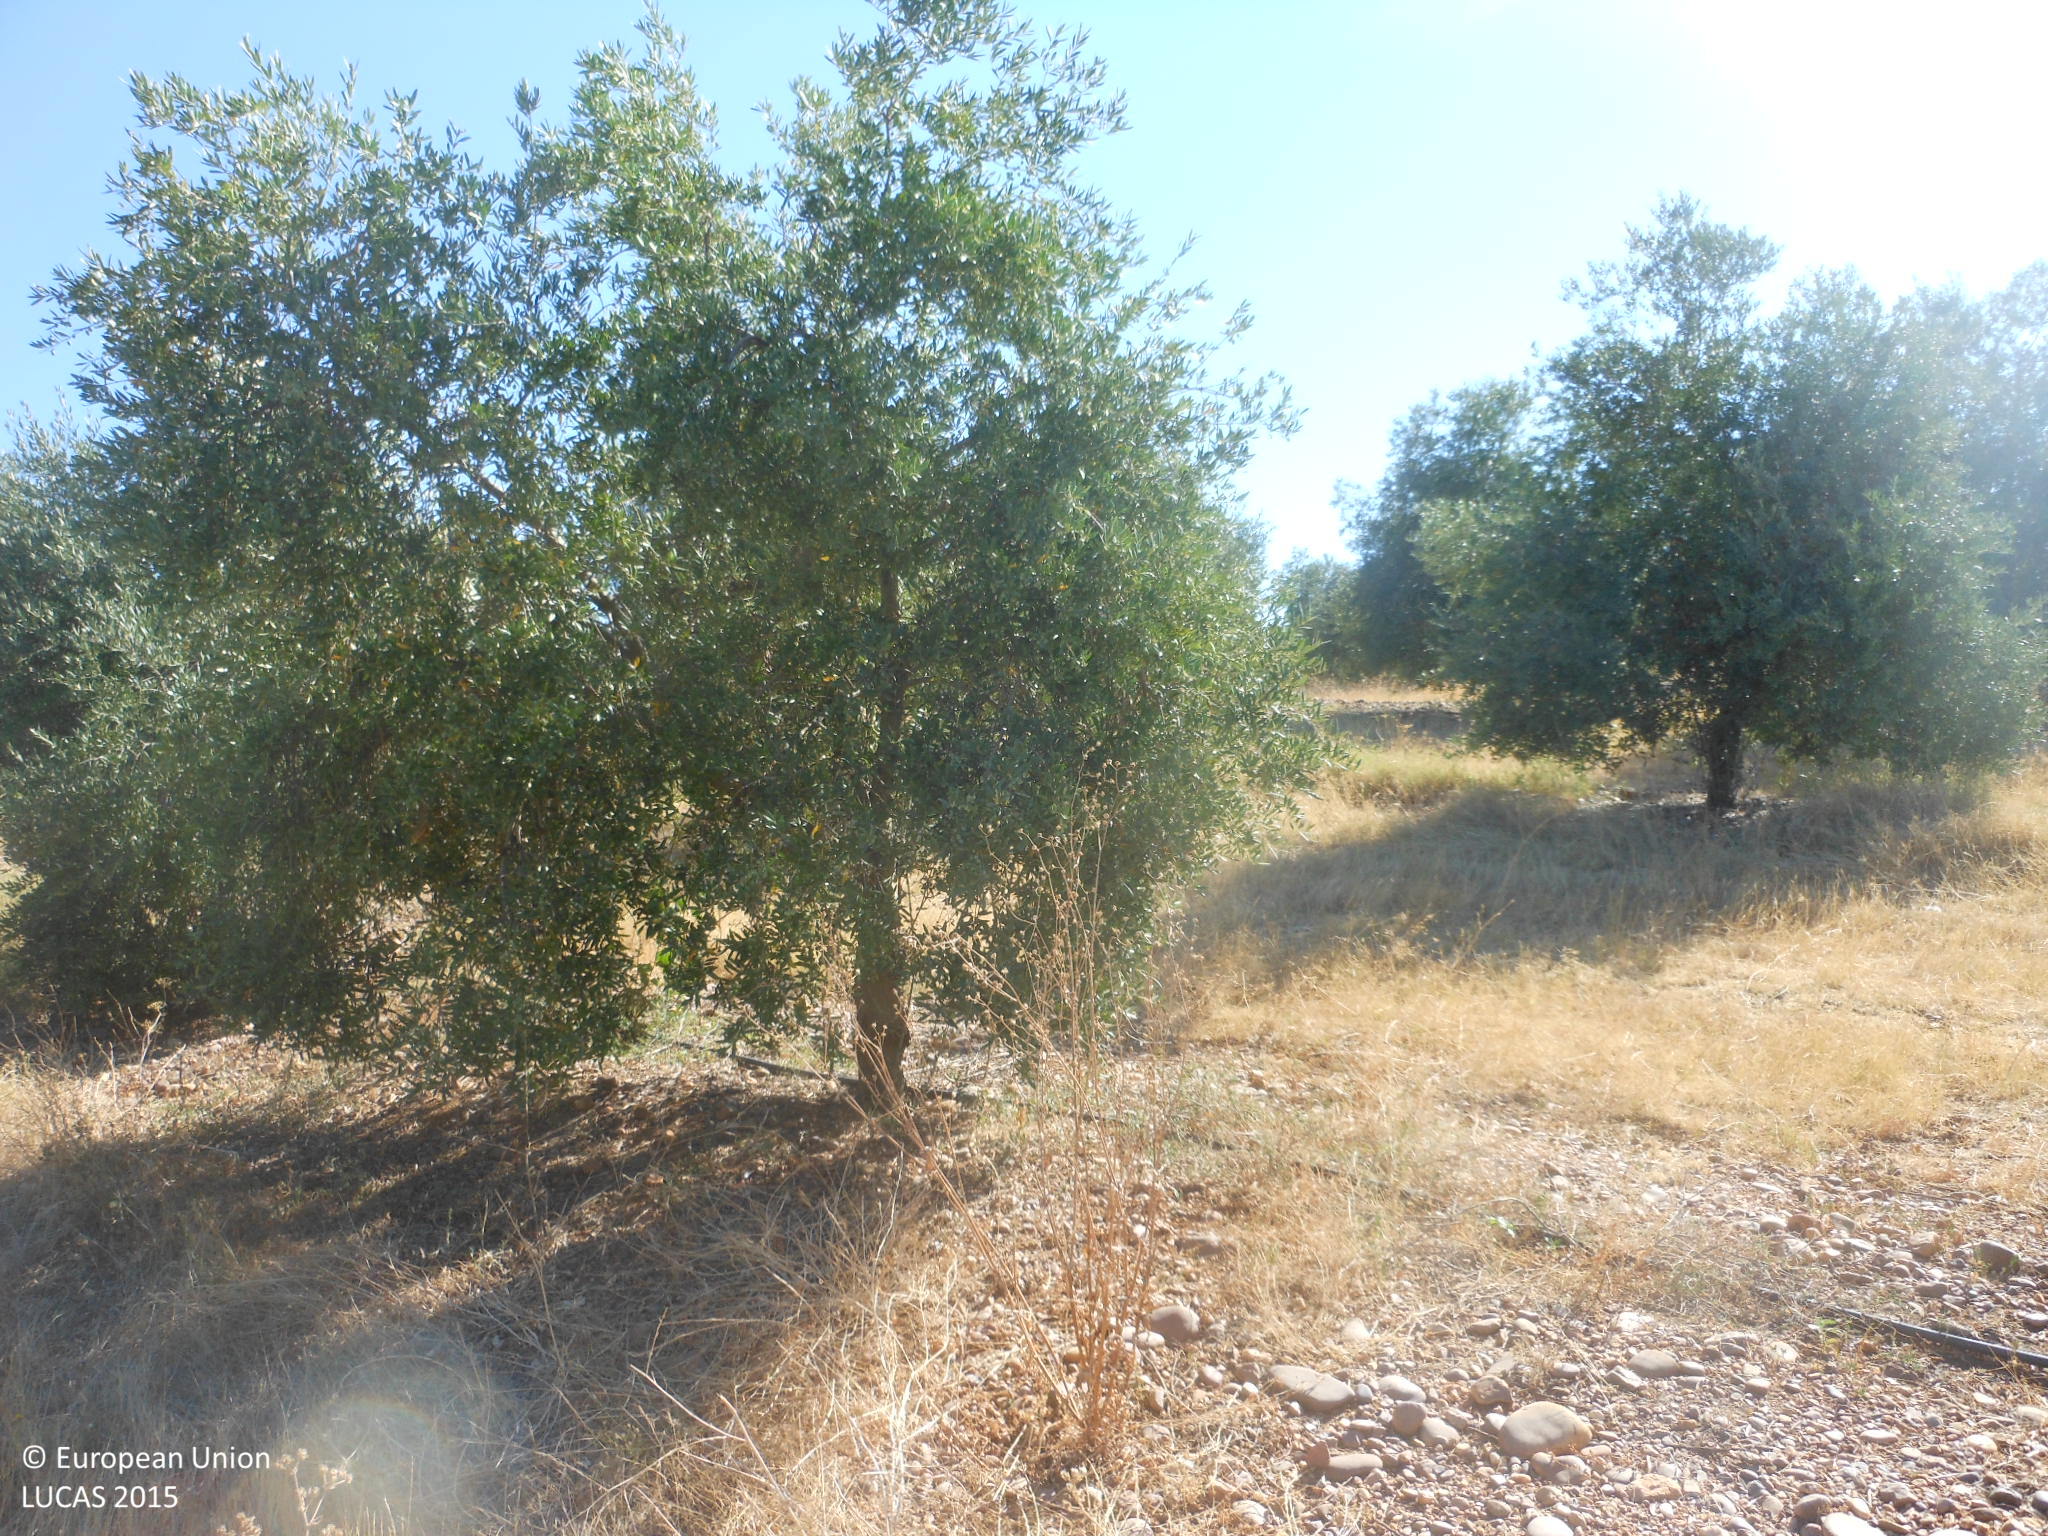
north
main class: Cropland
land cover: Olive groves
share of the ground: 25 - 50 %
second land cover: Spontaneously vegetated surfaces
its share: 50 - 75 %
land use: Agriculture (excluding fallow land and kitchen gardens)
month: July
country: ES
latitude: 37.5843
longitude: -5.5458
